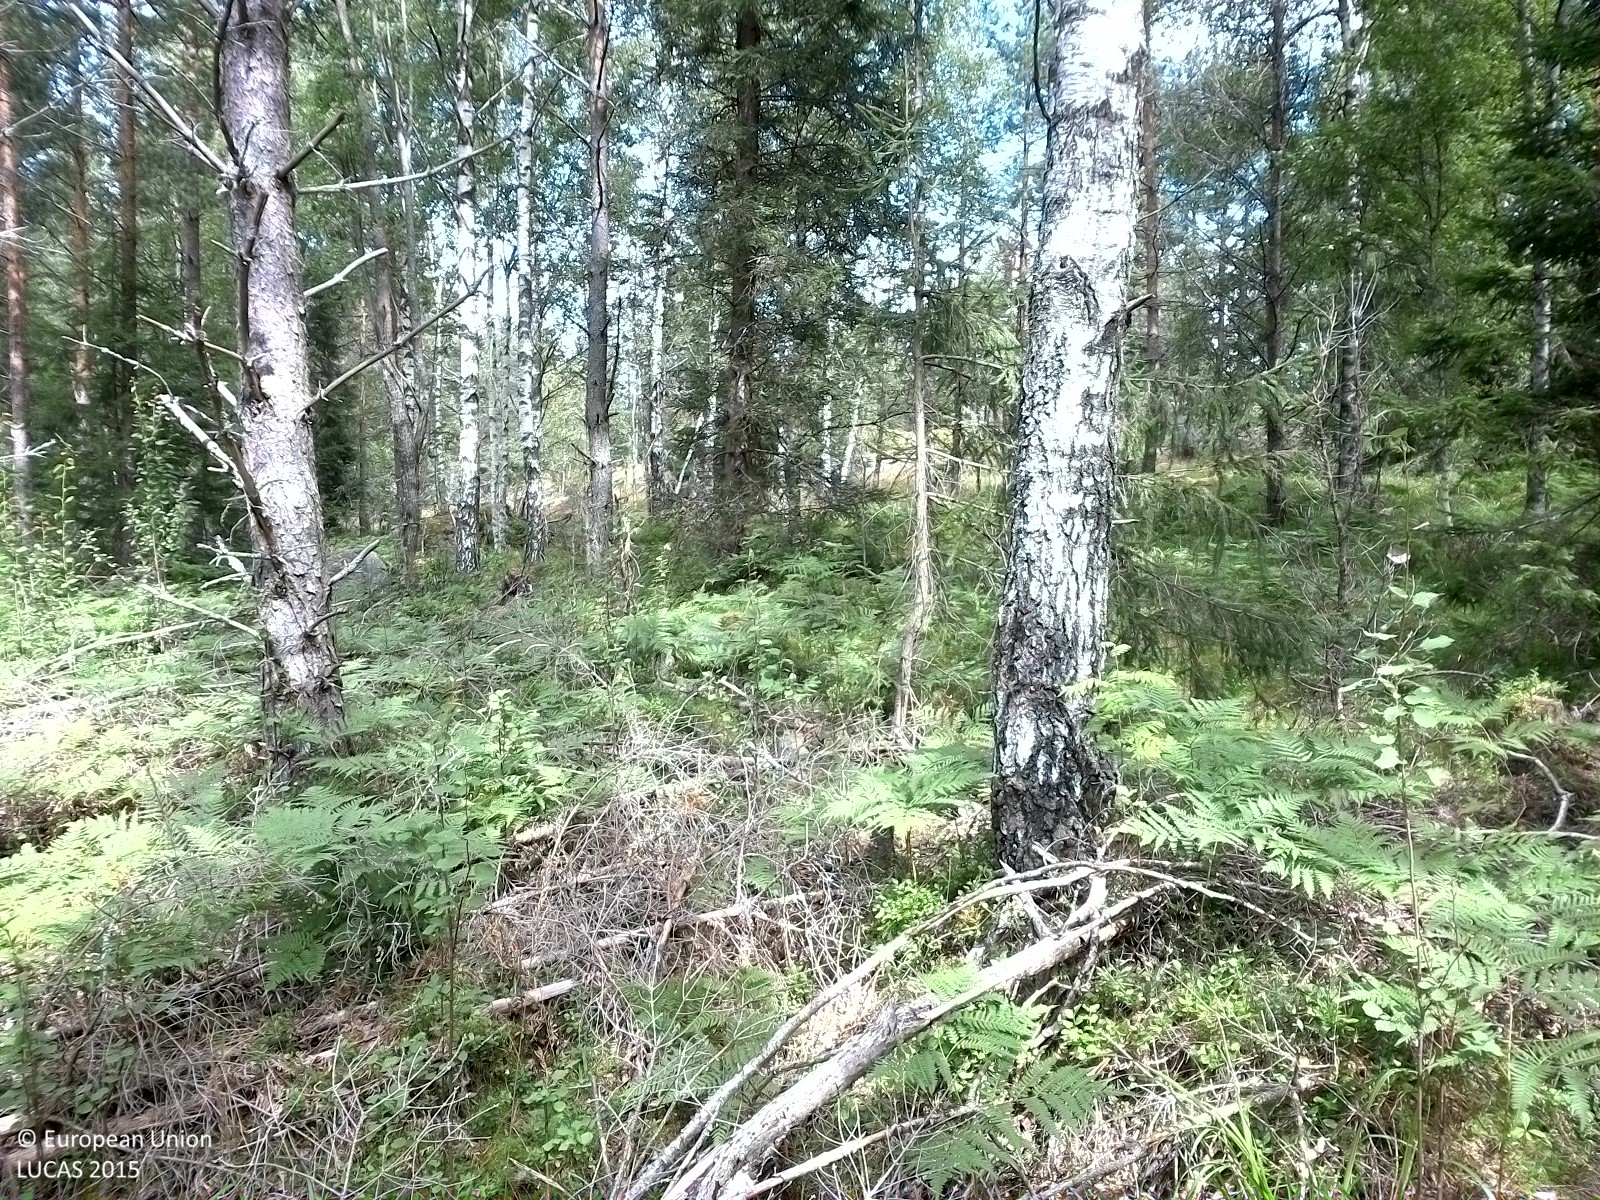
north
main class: Woodland
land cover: Pine dominated mixed woodland
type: boreal forest
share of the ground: 25 - 50 %
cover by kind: herbaceous plants 65 %, coniferous forest trees 20 %, broadleaved forest trees 10 %, lichens and mosses 5 %
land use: Forestry
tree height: > 5 m
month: August
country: SE
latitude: 59.0218
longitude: 15.1656
